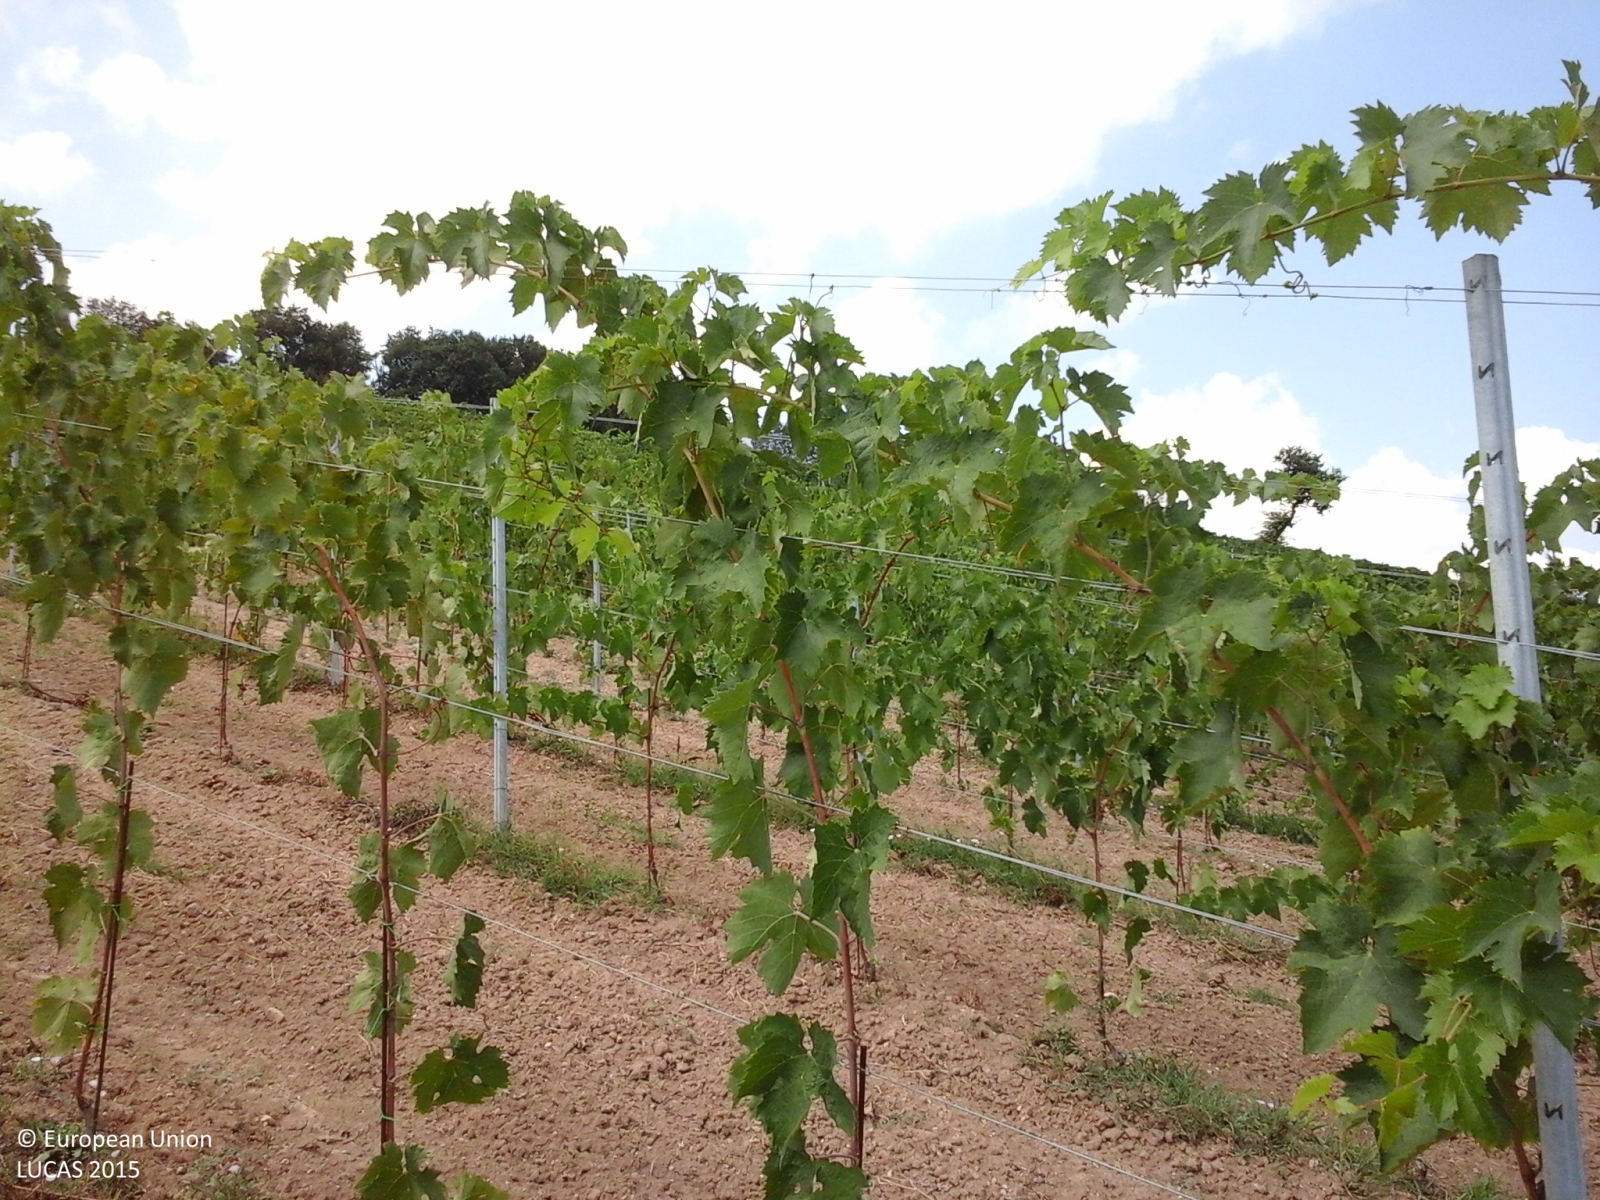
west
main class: Cropland
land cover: Vineyards
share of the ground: 25 - 50 %
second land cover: Spontaneously vegetated surfaces
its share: 25 - 50 %
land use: Agriculture (excluding fallow land and kitchen gardens)
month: August
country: IT
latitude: 42.6682
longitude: 13.9297
